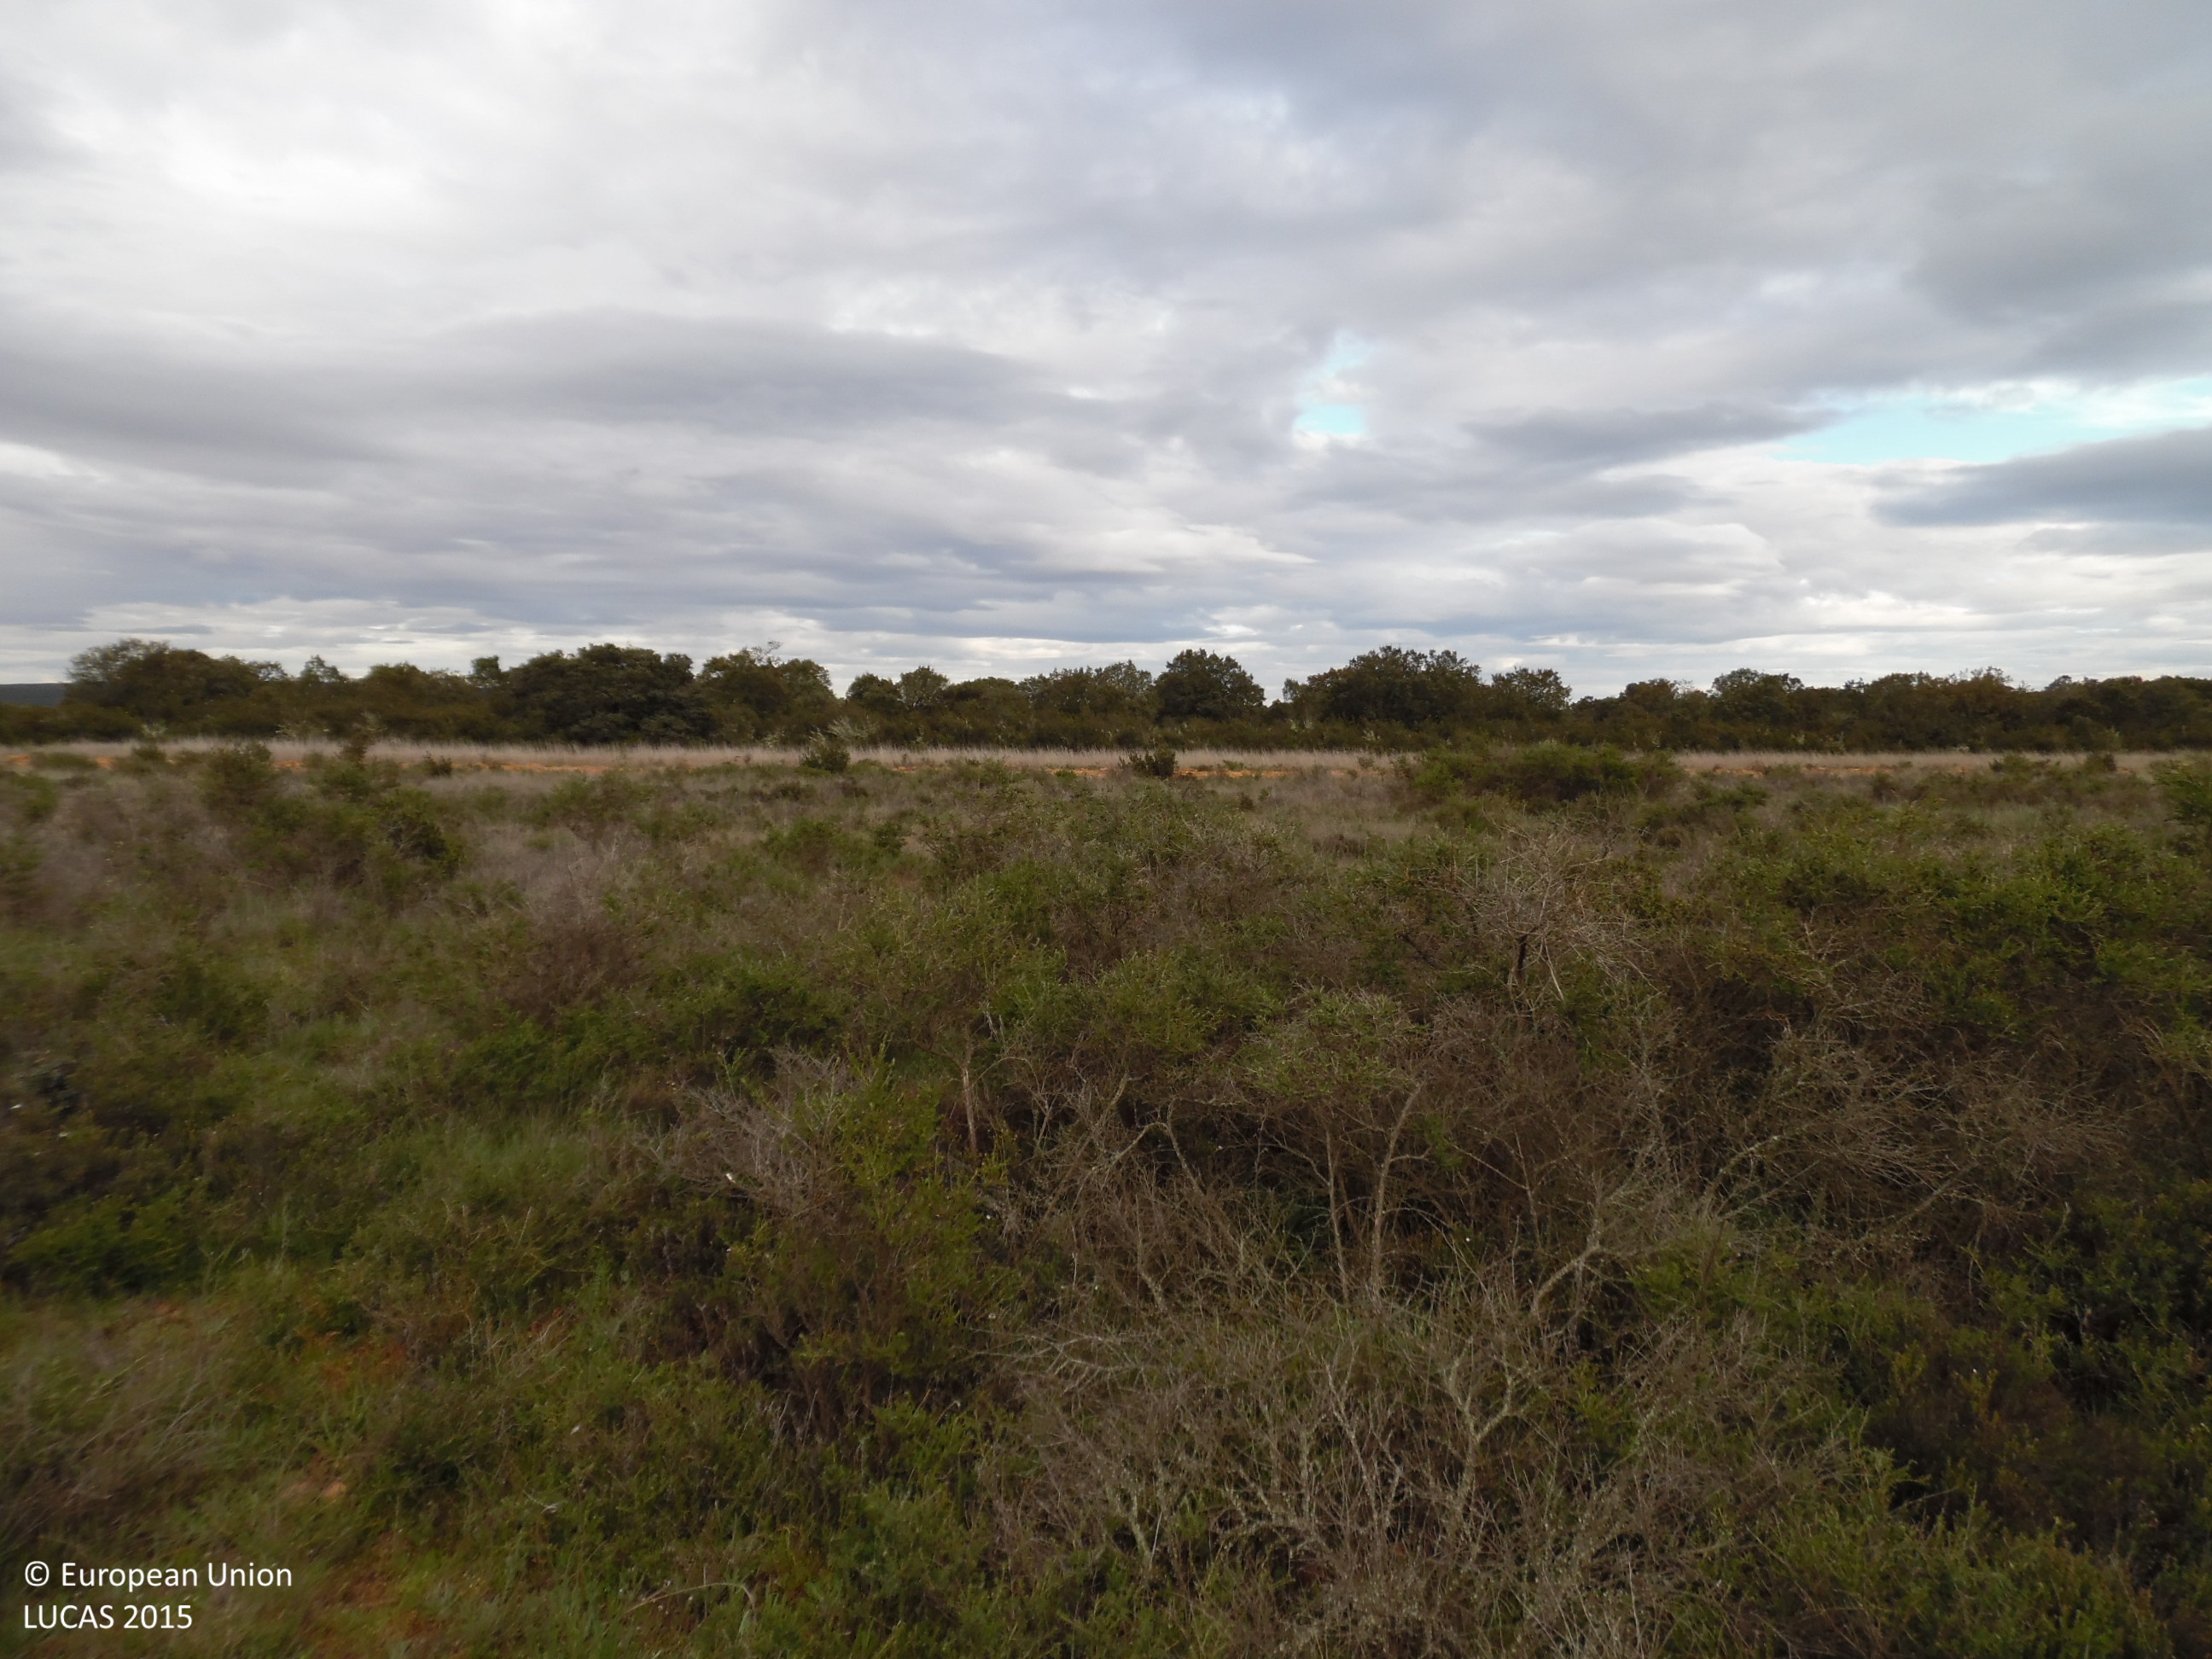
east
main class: Shrubland
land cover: Shrubland without tree cover
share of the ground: > 75 %
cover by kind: shrubs 100 %
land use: Abandoned areas
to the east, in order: Shrubland without tree cover; Other bare soil; Spontaneously vegetated surfaces; Broadleaved woodland; Grassland with sparse tree/shrub cover; Shrubland with sparse tree cover; Shrubland without tree cover; Barley
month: April
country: ES
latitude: 42.1813
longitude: -5.9977
